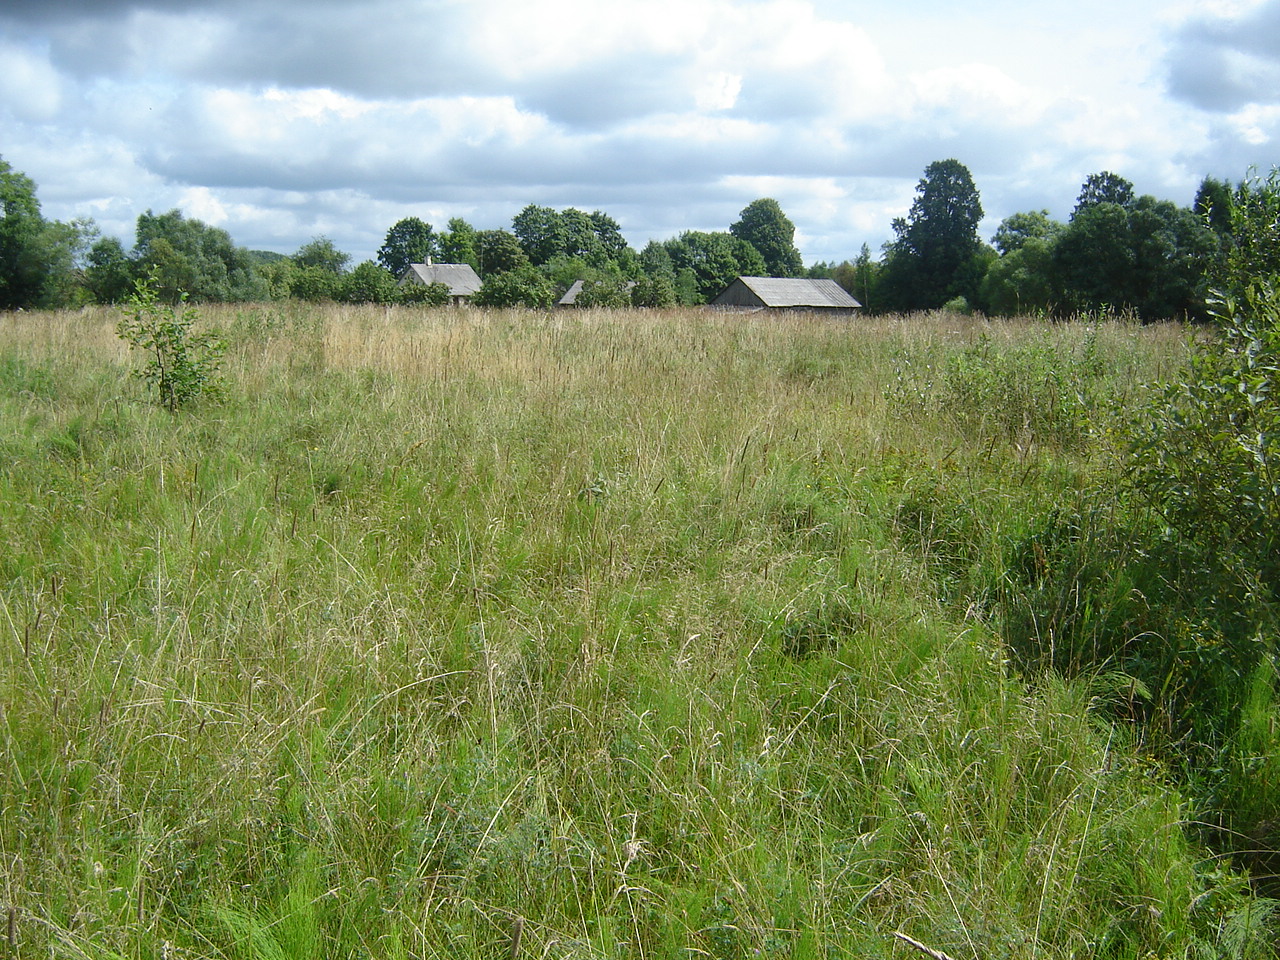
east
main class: Grassland
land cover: Grassland with sparse tree/shrub cover
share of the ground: > 75 %
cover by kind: herbaceous plants 95 %, broadleaved forest trees 5 %
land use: Fallow land
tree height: < 5 m
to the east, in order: Grassland with sparse tree/shrub cover; Spontaneously vegetated surfaces; Grassland without tree/shrub cover; Ditches and canals; Grassland without tree/shrub cover; Artificial constructions in urban areas; Grassland without tree/shrub cover; Spontaneously vegetated surfaces; Broadleaved woodland
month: August
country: LT
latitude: 54.9264
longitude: 25.0483
